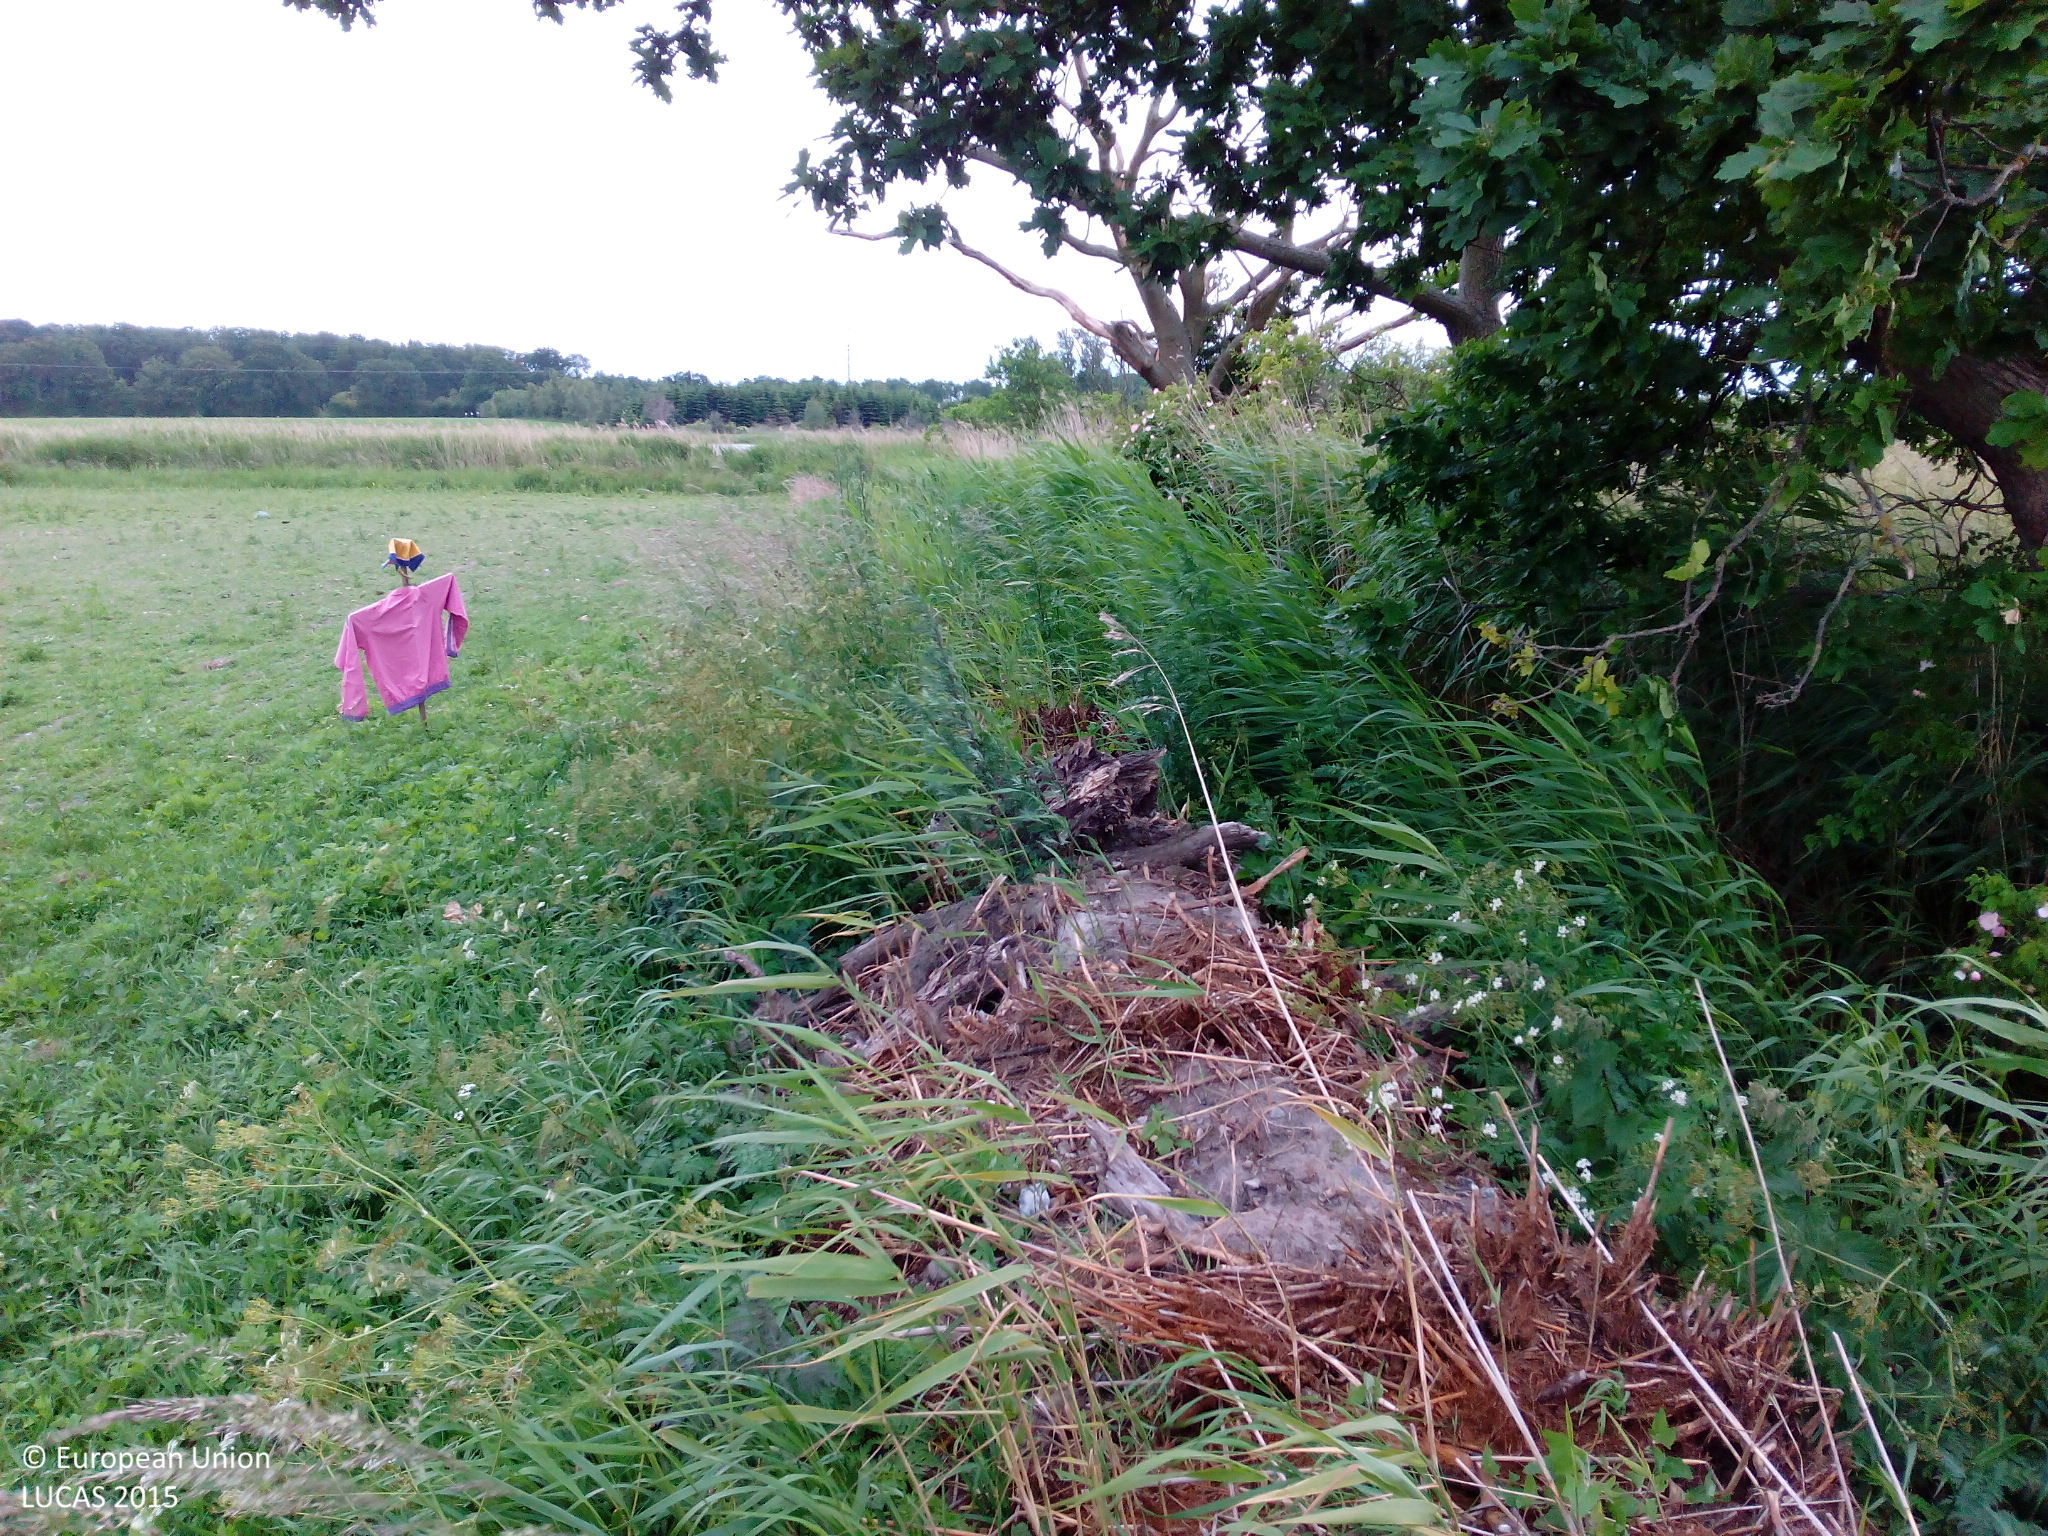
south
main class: Grassland
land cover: Grassland without tree/shrub cover
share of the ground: > 75 %
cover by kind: herbaceous plants 90 %, unconsolidated bare surface 10 %
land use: Agriculture (excluding fallow land and kitchen gardens)
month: June
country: DK
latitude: 54.8633
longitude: 11.7594
